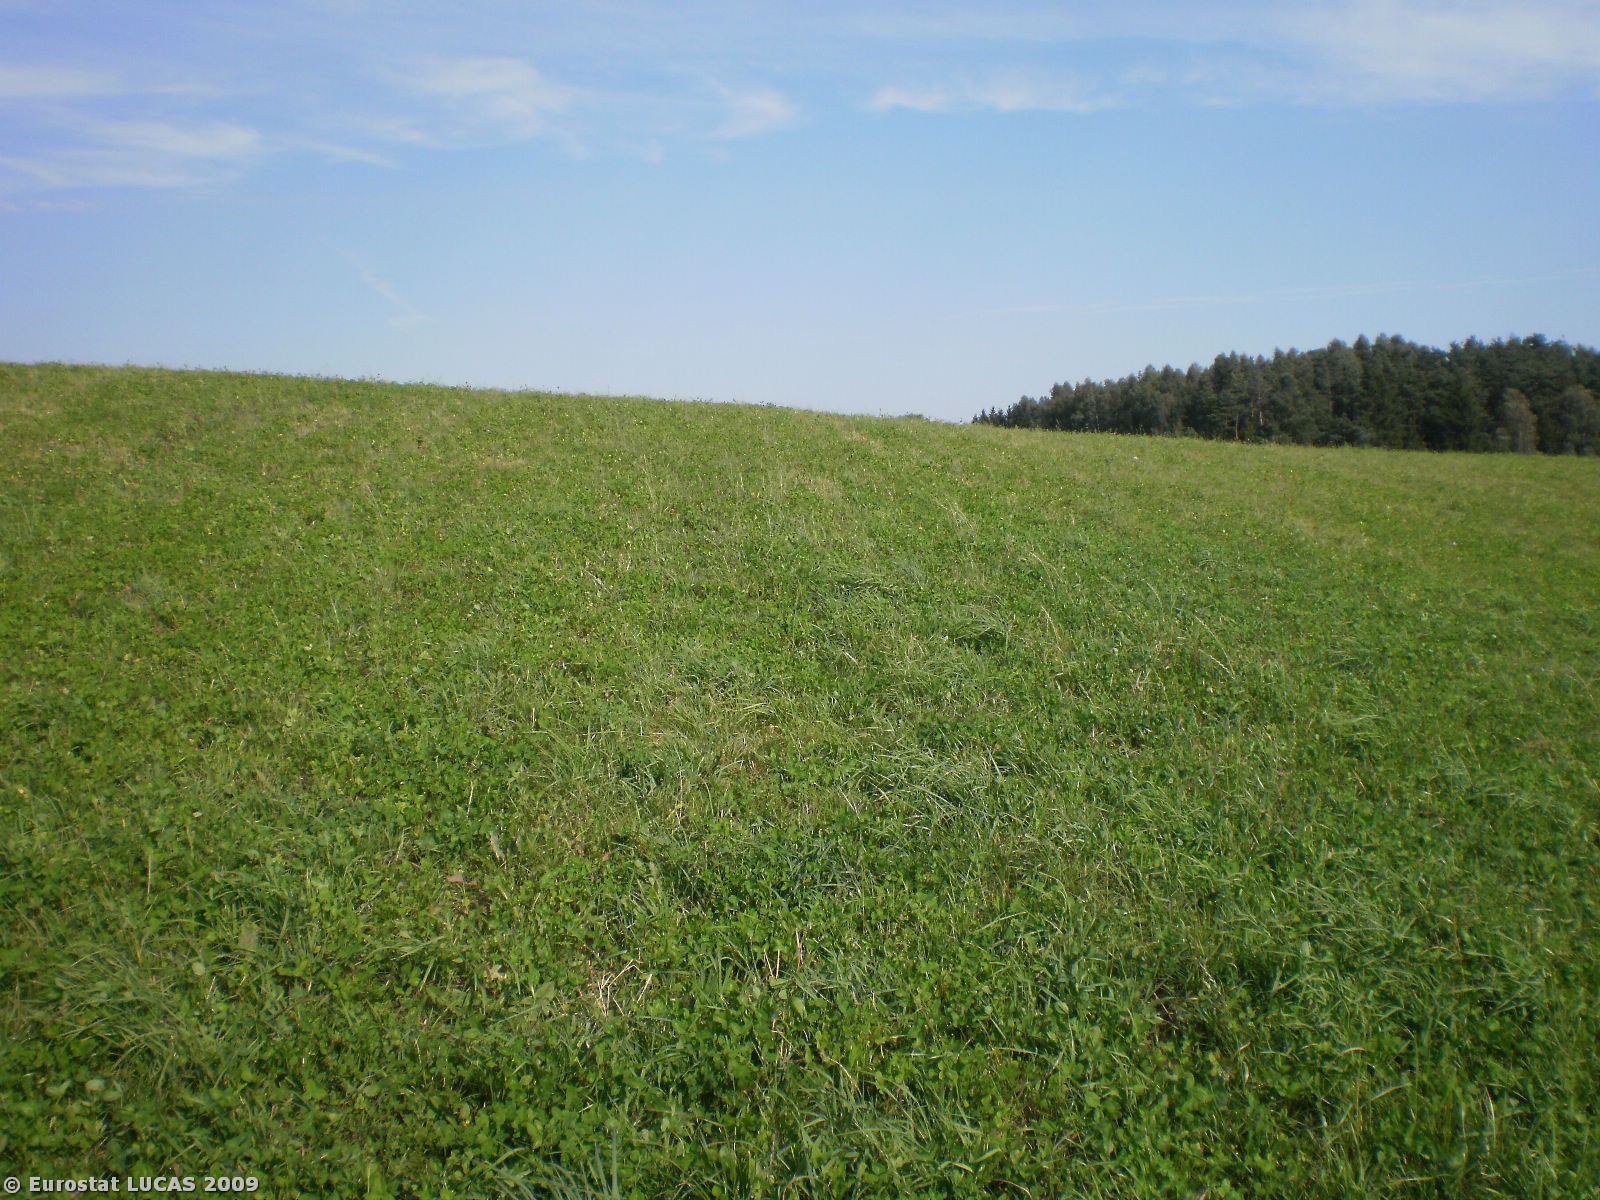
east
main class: Grassland
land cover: Grassland without tree/shrub cover
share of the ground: > 75 %
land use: Agriculture (excluding fallow land and kitchen gardens)
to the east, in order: Grassland without tree/shrub cover; Fences; Maize
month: September
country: PL
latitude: 53.6725
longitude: 21.0790
